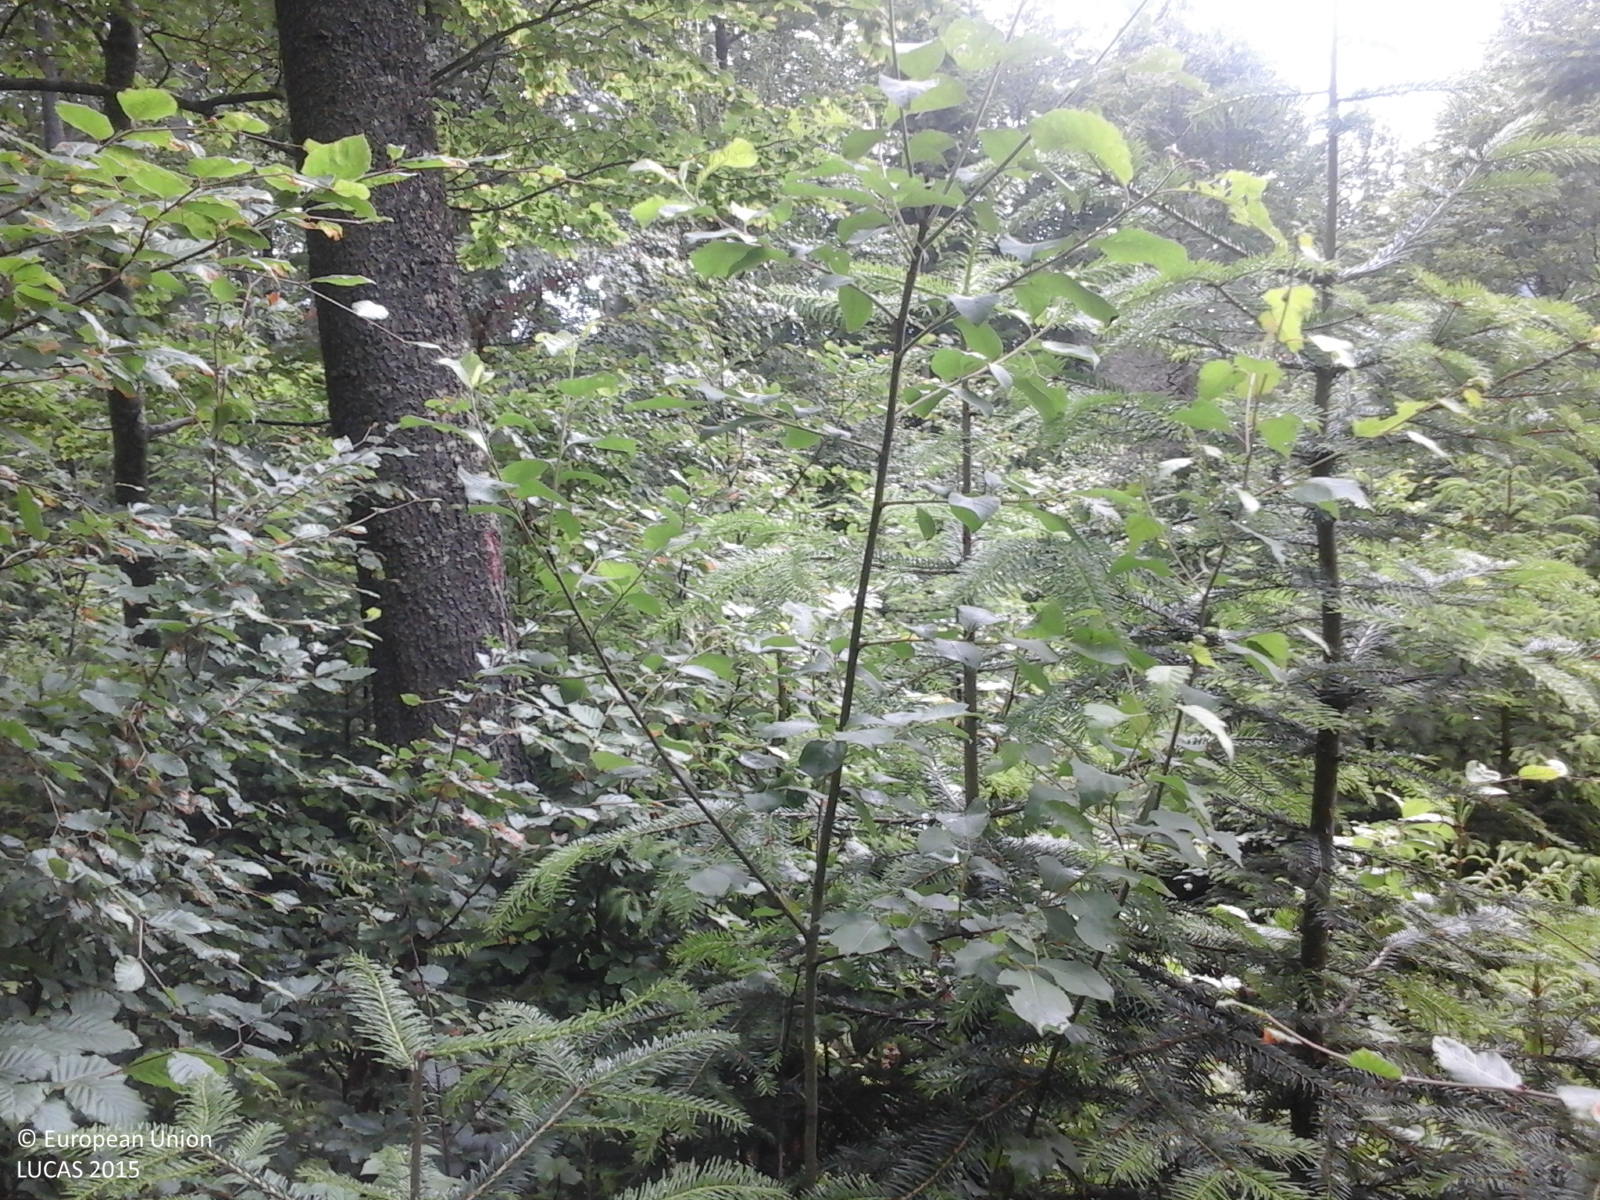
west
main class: Woodland
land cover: Spruce dominated mixed woodland
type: alpine coniferous forest
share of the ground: > 75 %
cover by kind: coniferous forest trees 70 %, broadleaved forest trees 25 %, shrubs 5 %
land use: Forestry
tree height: > 5 m
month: June
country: RO
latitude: 47.3995
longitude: 25.2001
